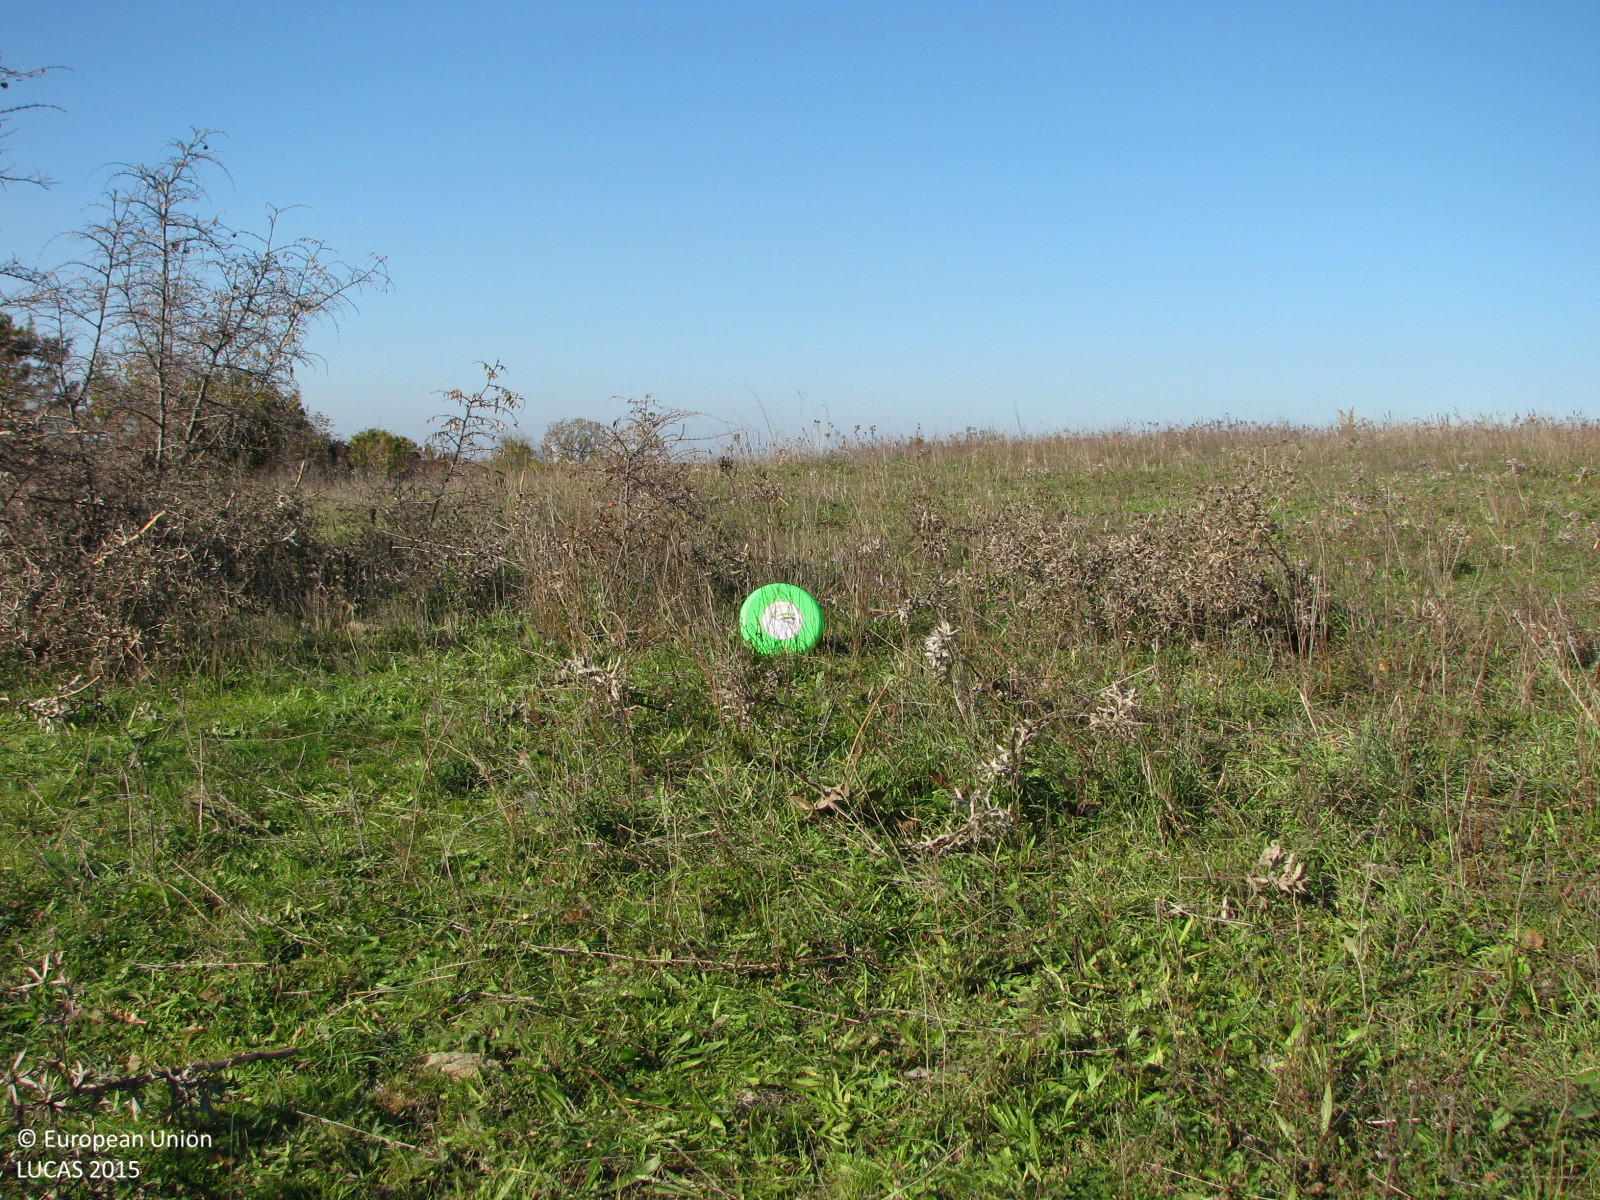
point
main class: Grassland
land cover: Grassland with sparse tree/shrub cover
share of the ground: > 75 %
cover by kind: herbaceous plants 90 %, broadleaved forest trees 5 %, shrubs 5 %
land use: Agriculture (excluding fallow land and kitchen gardens)
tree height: < 5 m
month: November
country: BG
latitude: 42.0564
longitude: 26.7556
